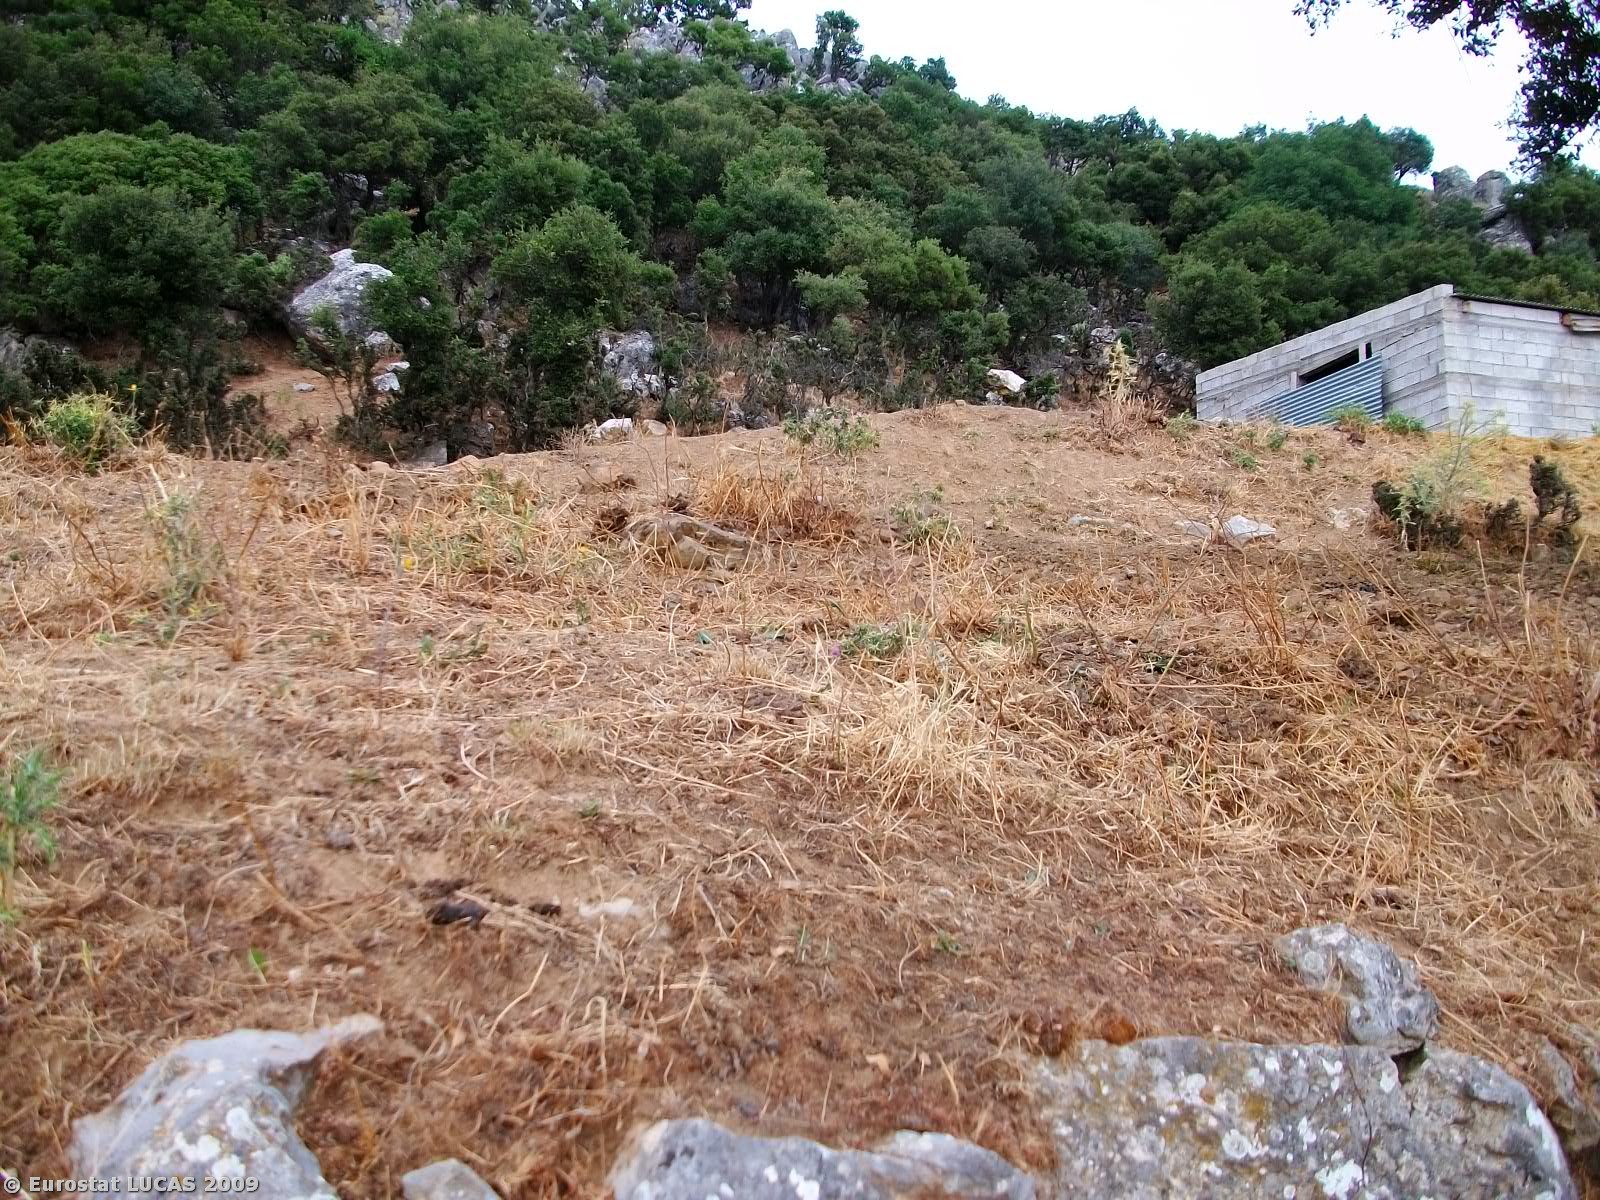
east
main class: Grassland
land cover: Grassland with sparse tree/shrub cover
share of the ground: 50 - 75 %
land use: Agriculture (excluding fallow land and kitchen gardens)
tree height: < 5 m
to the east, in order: Grassland with sparse tree/shrub cover; Tracks; Shrubland with sparse tree cover; Tracks; Shrubland with sparse tree cover; Grassland with sparse tree/shrub cover; Abandoned hedges; Shrubland without tree cover; Grassland without tree/shrub cover
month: June
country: GR
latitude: 38.5525
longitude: 22.1950
